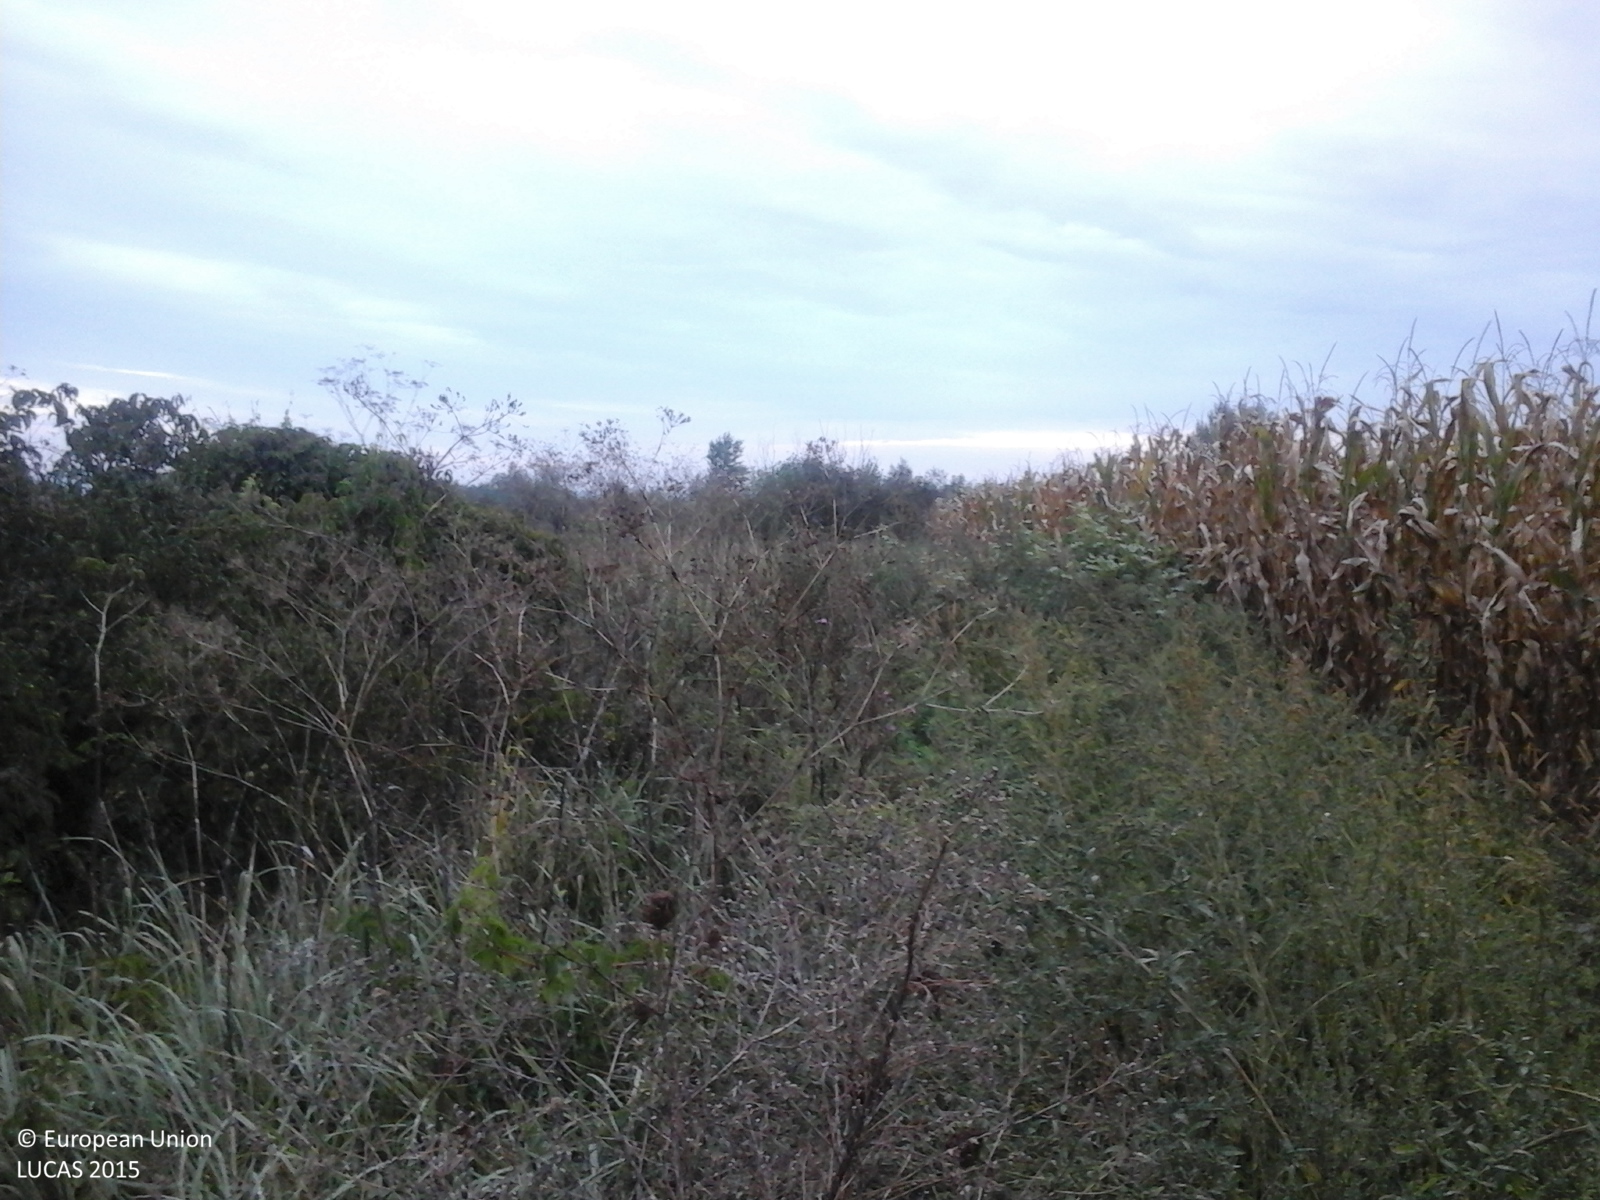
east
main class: Cropland
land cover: Maize
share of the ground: > 75 %
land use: Agriculture (excluding fallow land and kitchen gardens)
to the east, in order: Maize; Broadleaved woodland; Rivers and streams; Broadleaved woodland; Spontaneously vegetated surfaces
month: September
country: RO
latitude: 47.0633
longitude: 22.0962
